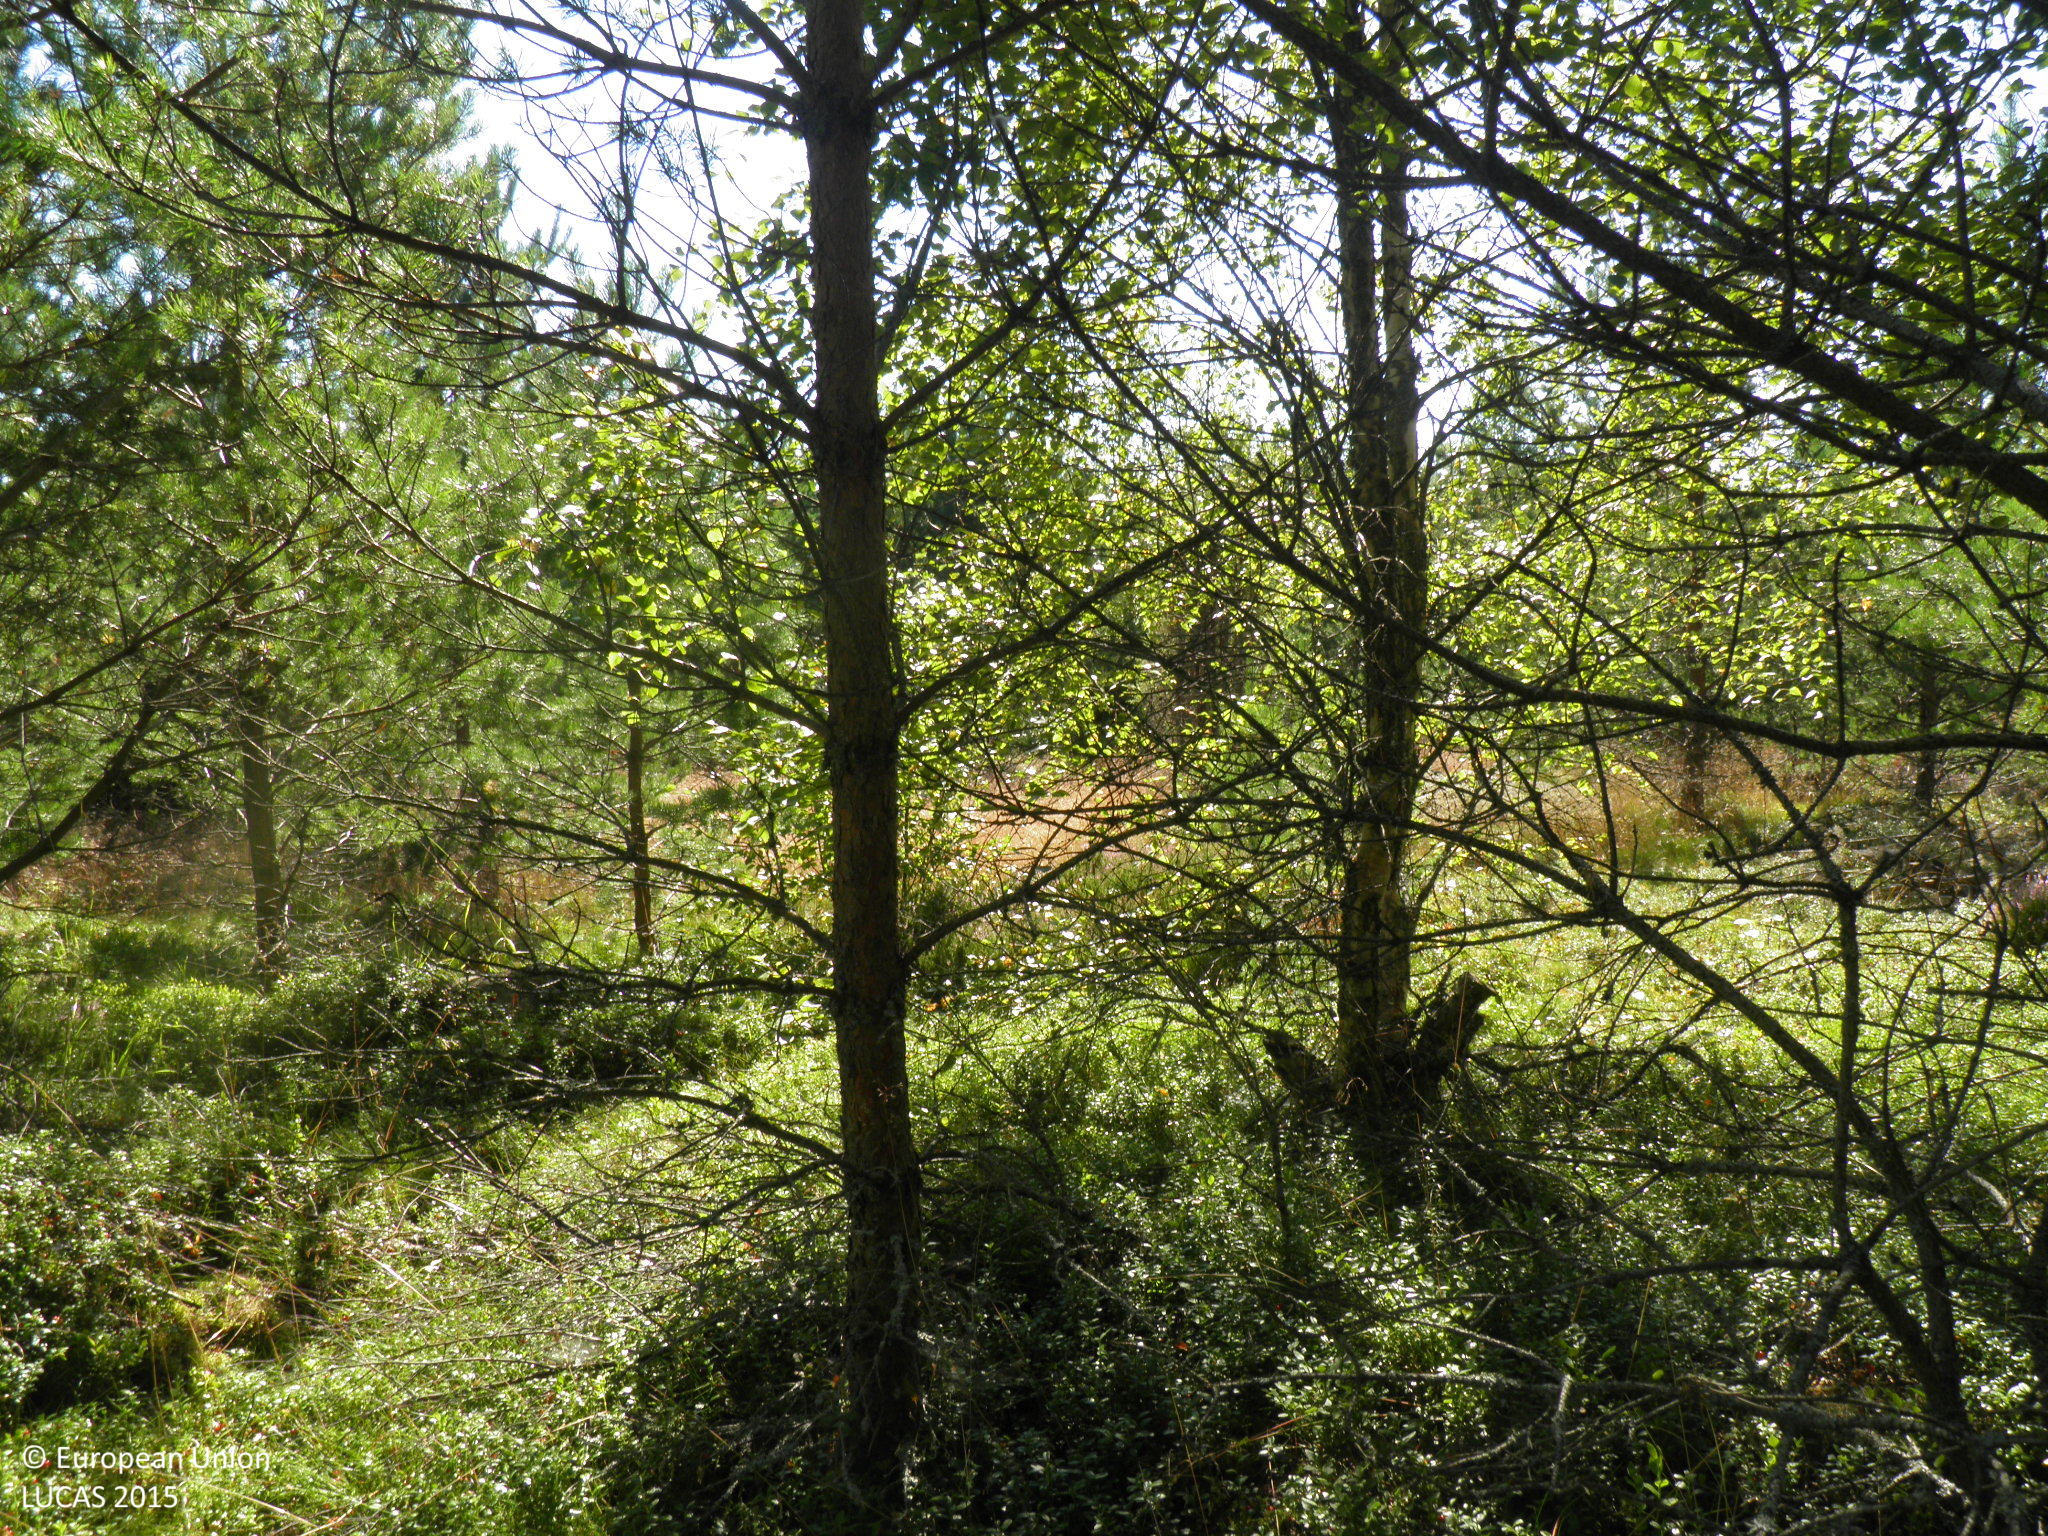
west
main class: Woodland
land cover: Pine dominated coniferous woodland
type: hemiboreal forest and nemoral coniferous forest and mixed broadleaved-coniferous forest
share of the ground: > 75 %
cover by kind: coniferous forest trees 80 %, shrubs 10 %, herbaceous plants 10 %
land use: Forestry
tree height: < 5 m
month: August
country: FI
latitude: 60.8107
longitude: 21.6183
